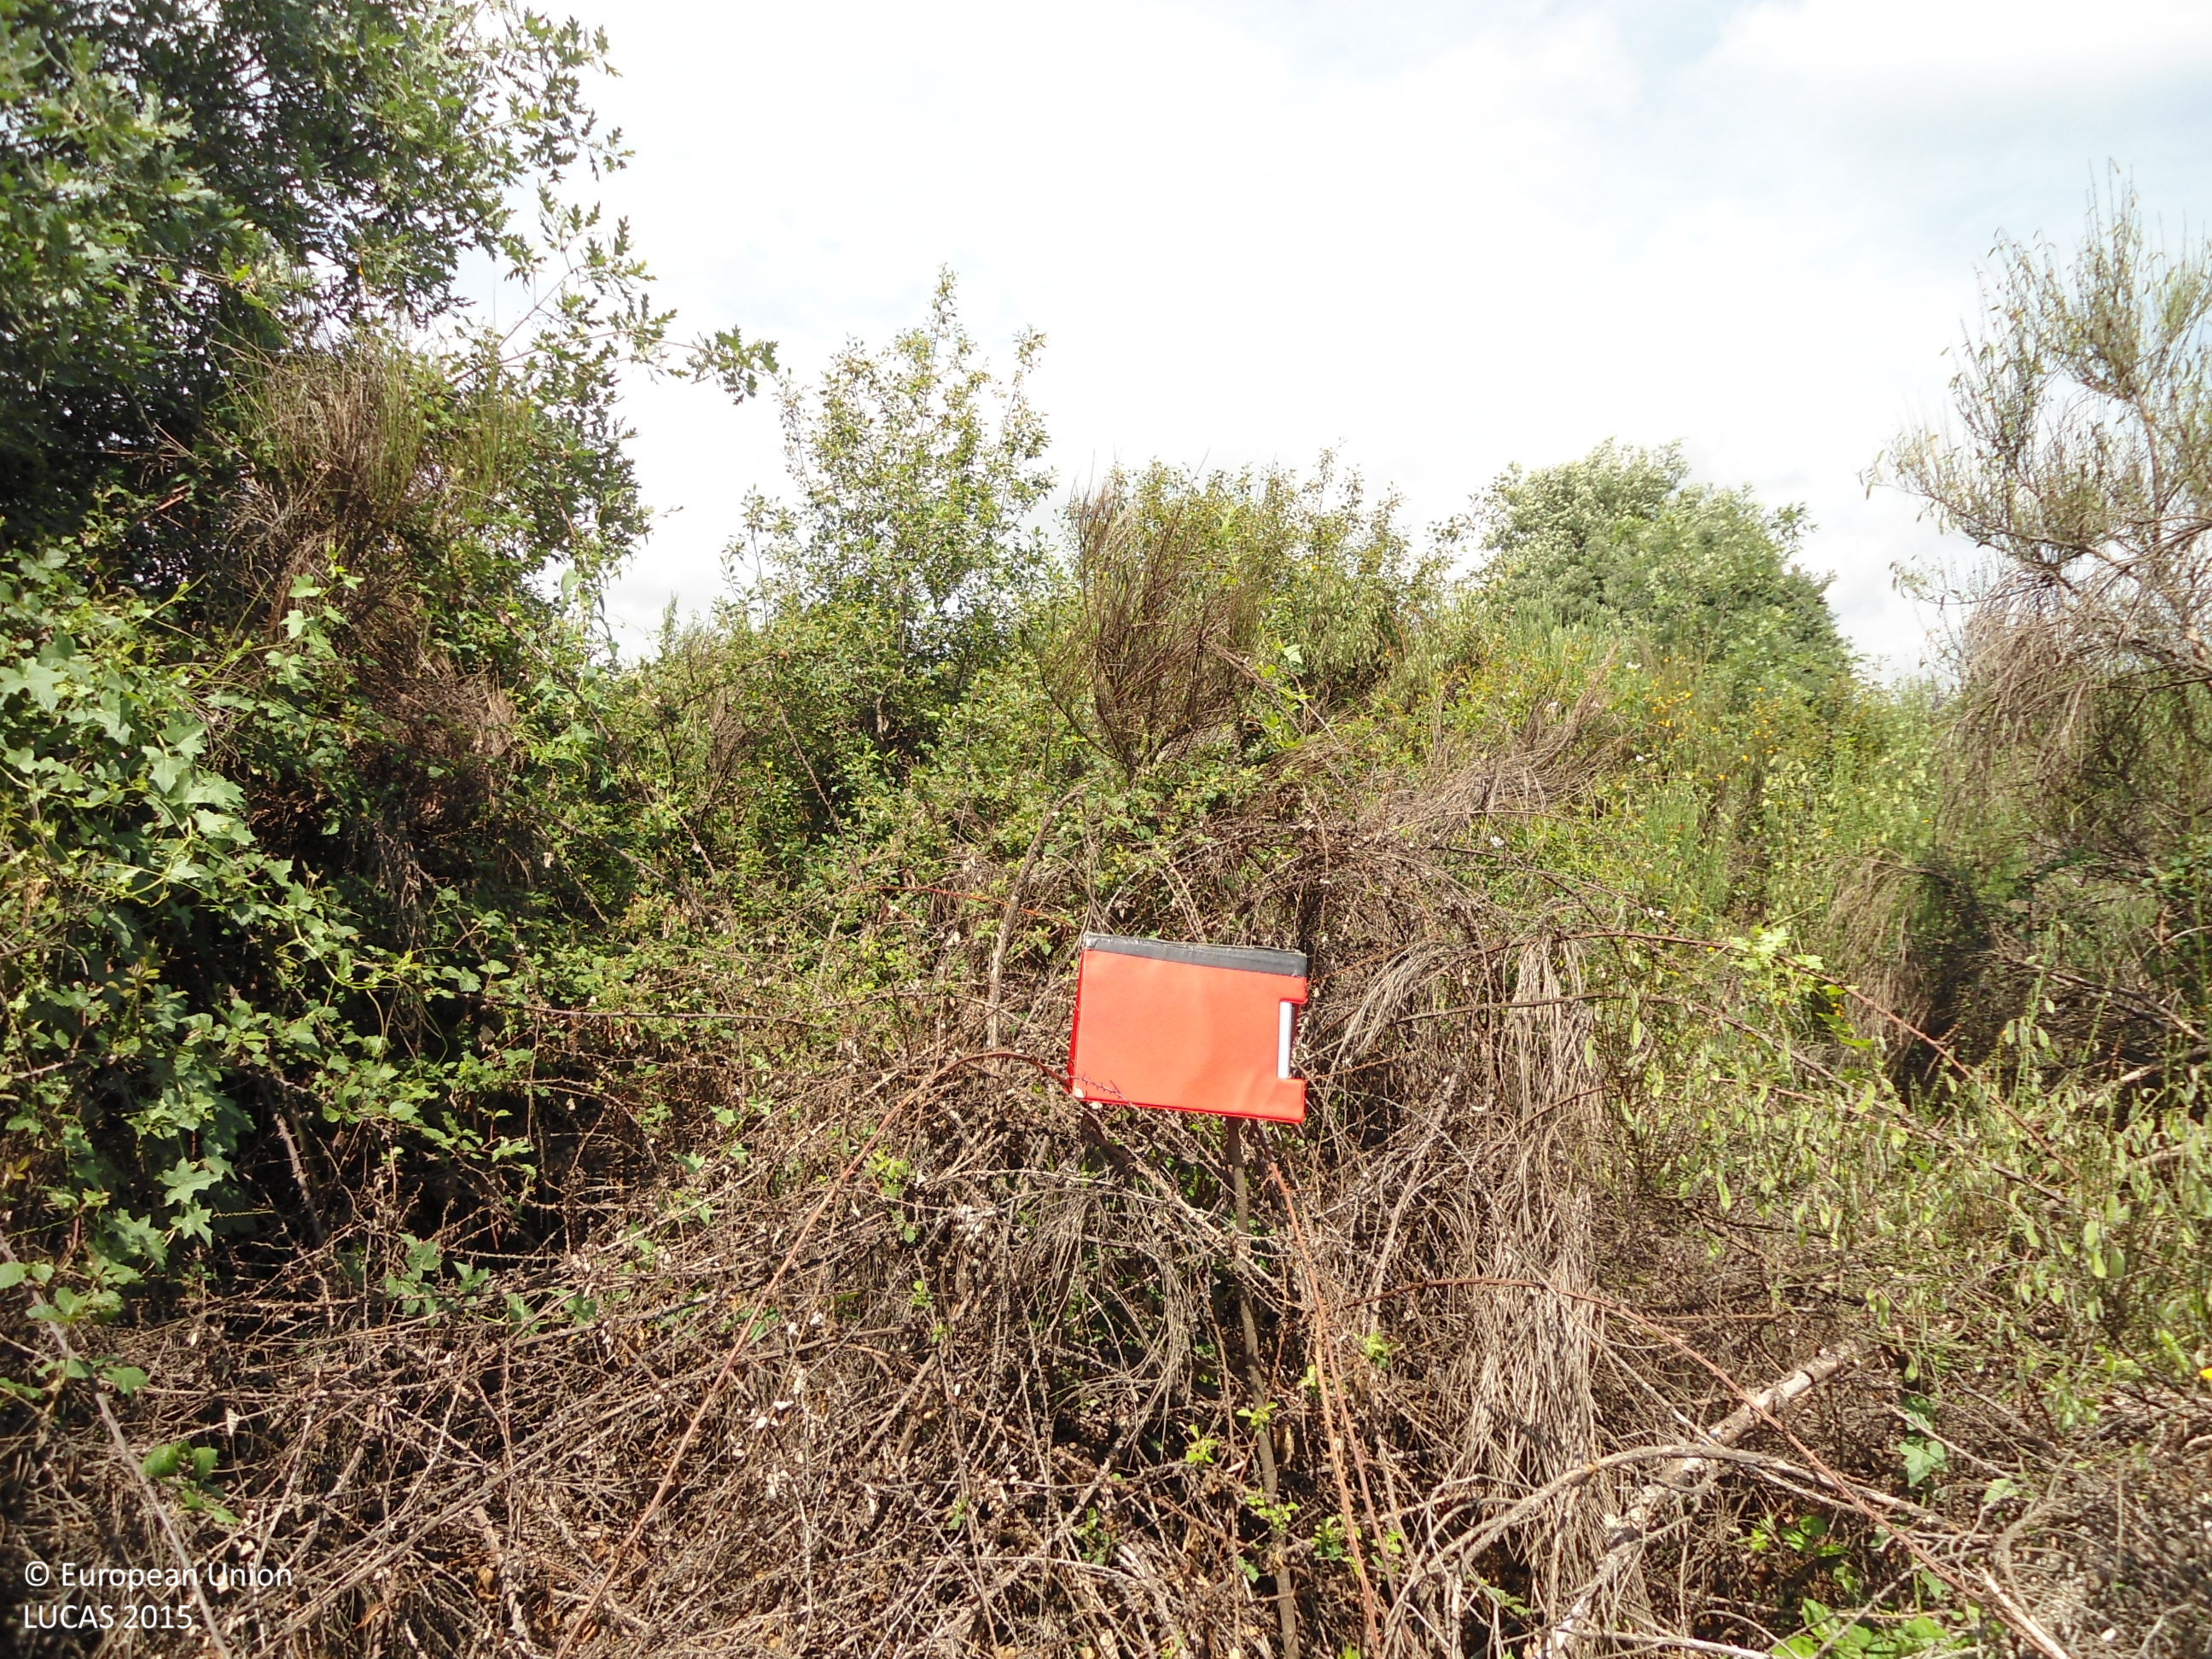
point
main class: Shrubland
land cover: Shrubland with sparse tree cover
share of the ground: > 75 %
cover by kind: shrubs 95 %, broadleaved forest trees 5 %
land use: Semi-natural and natural areas not in use
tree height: > 5 m
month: June
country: ES
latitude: 42.0609
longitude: -6.5093
